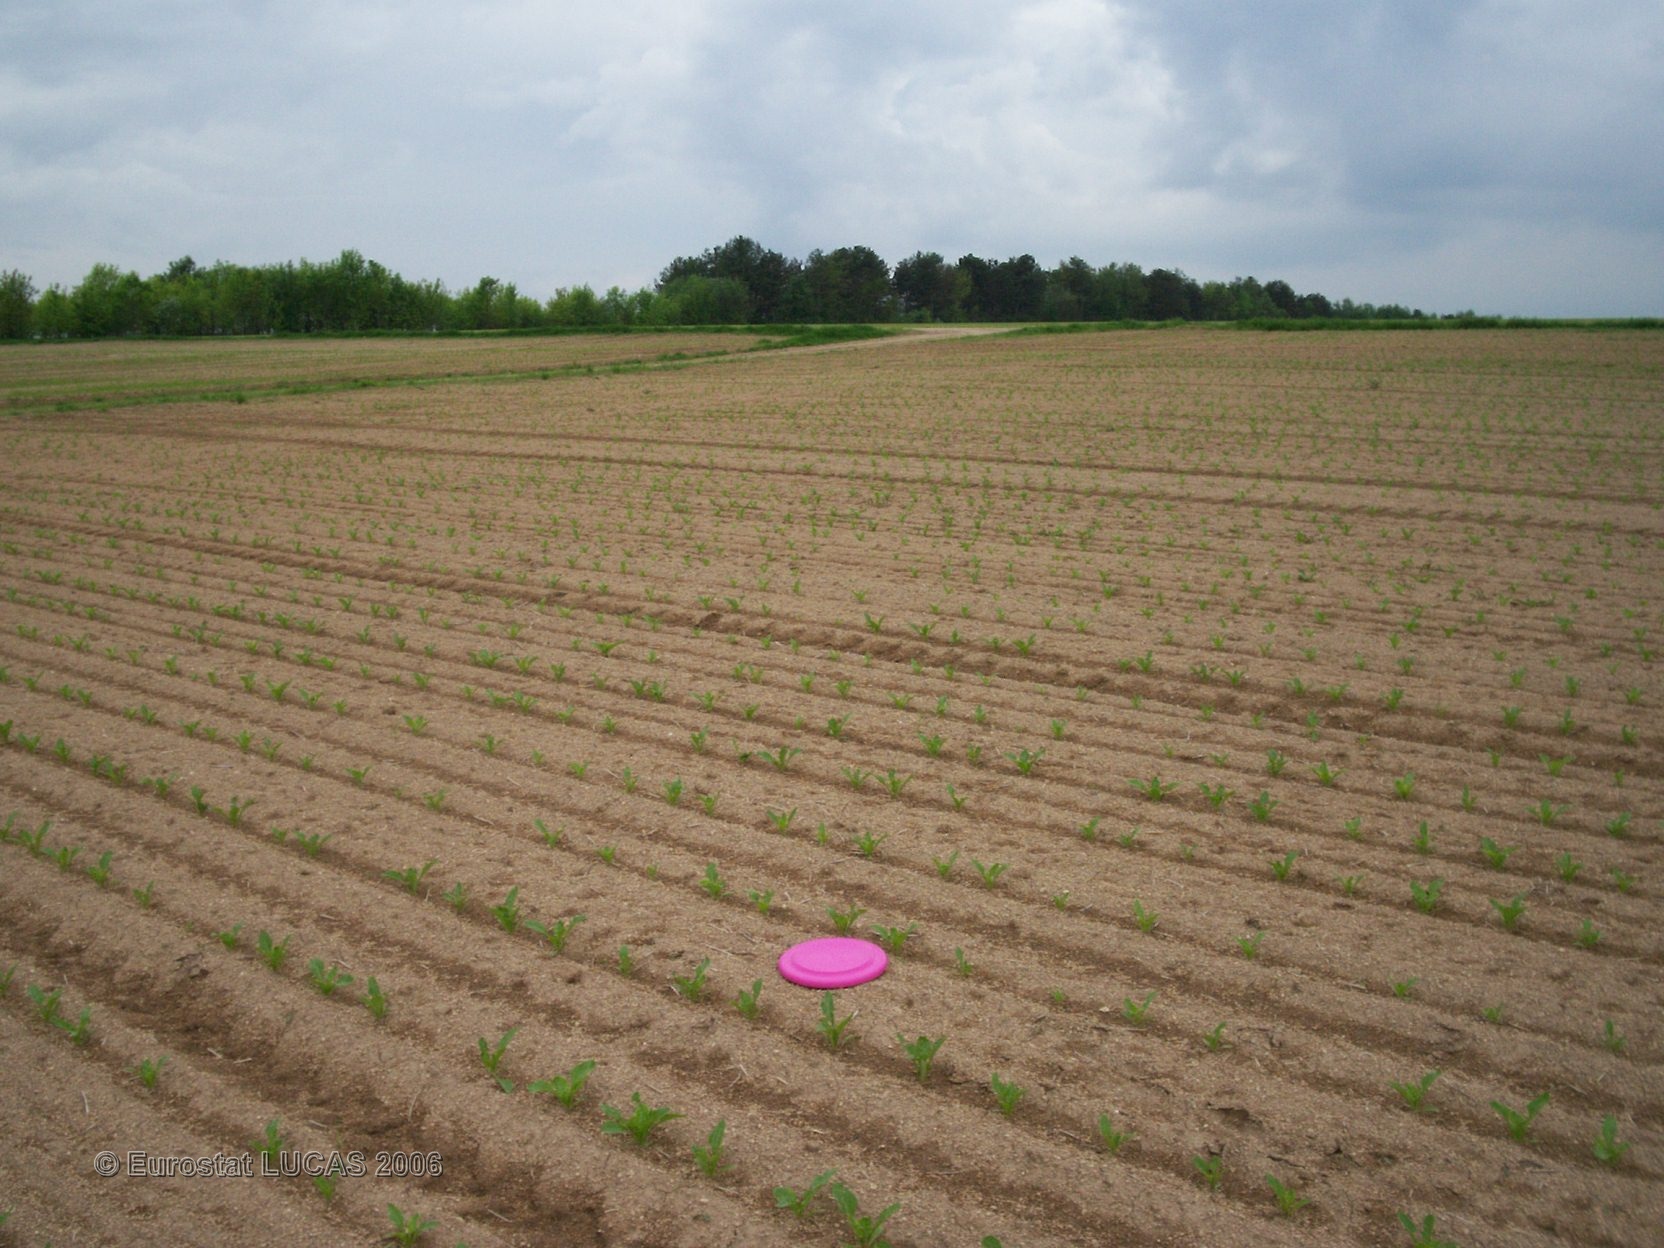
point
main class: Cropland
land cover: Sugar beet
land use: Agriculture (excluding fallow land and kitchen gardens)
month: May
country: FR
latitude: 49.2688
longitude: 4.3475
